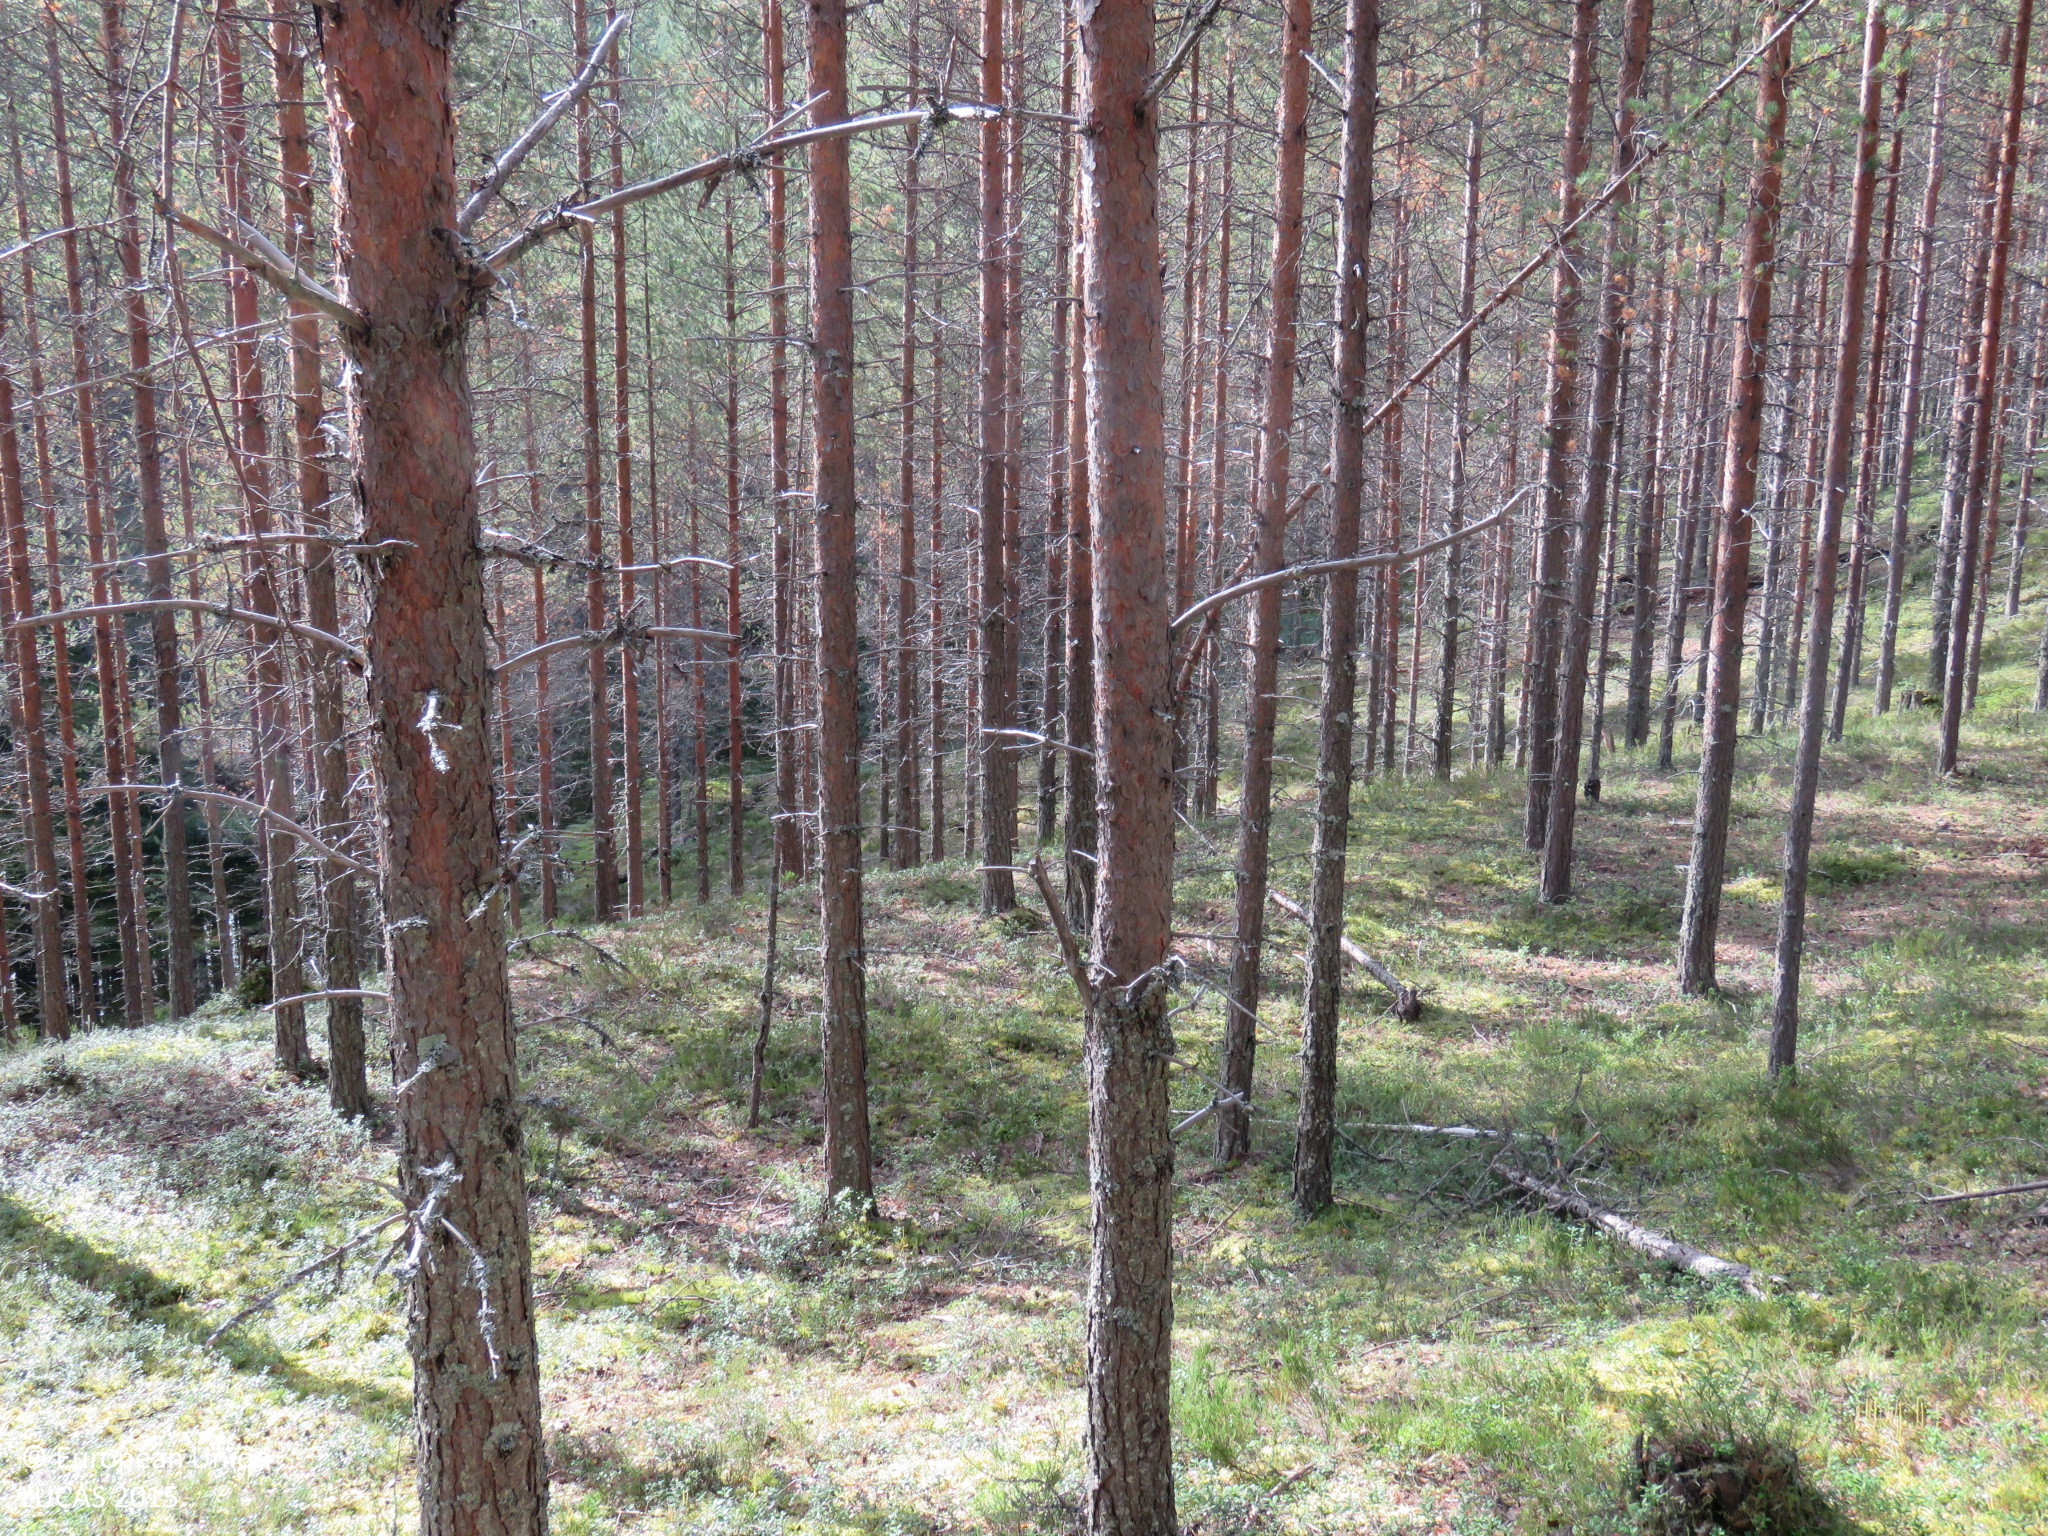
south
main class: Woodland
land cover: Pine dominated coniferous woodland
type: boreal forest
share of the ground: > 75 %
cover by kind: coniferous forest trees 80 %, shrubs 15 %, lichens and mosses 5 %
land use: Forestry
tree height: > 5 m
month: September
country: FI
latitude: 65.4352
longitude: 27.5727
